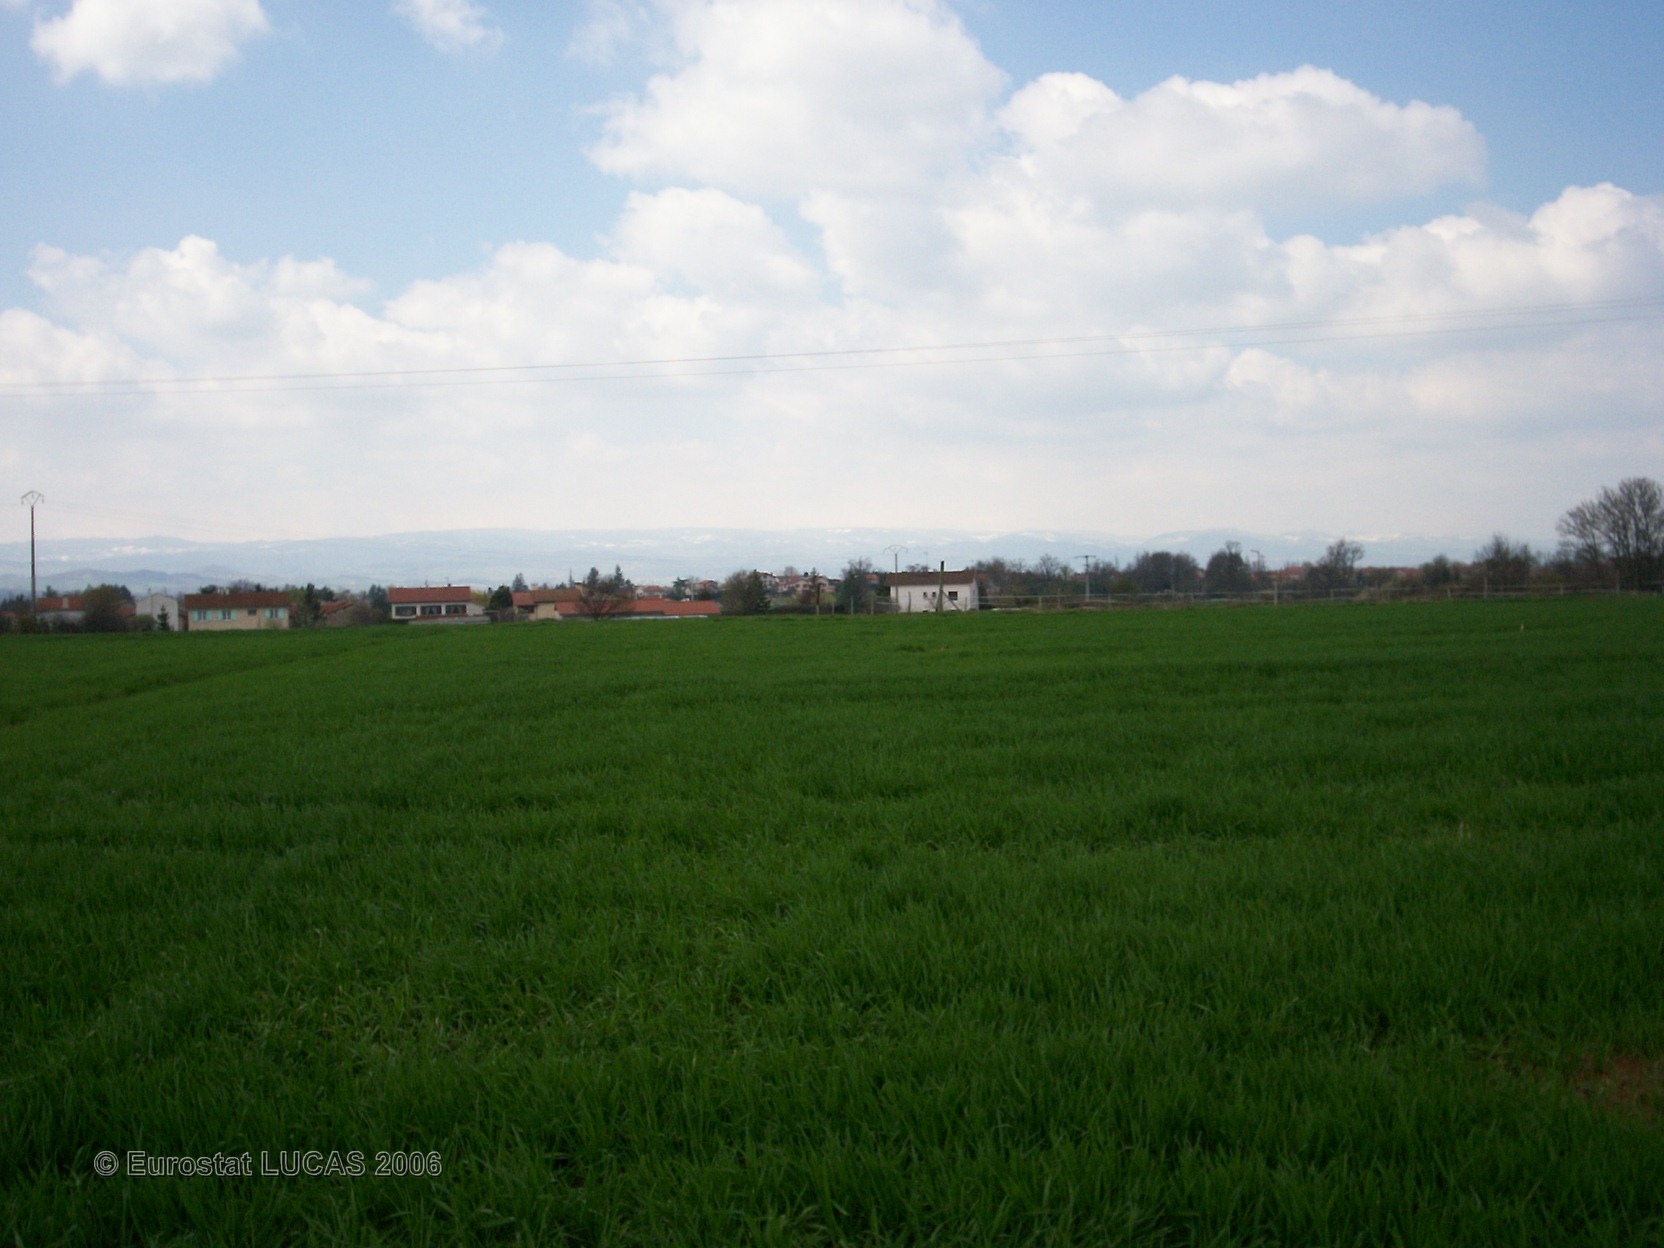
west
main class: Cropland
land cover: Common wheat
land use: Agriculture (excluding fallow land and kitchen gardens)
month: April
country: FR
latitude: 45.5437
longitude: 4.2014
